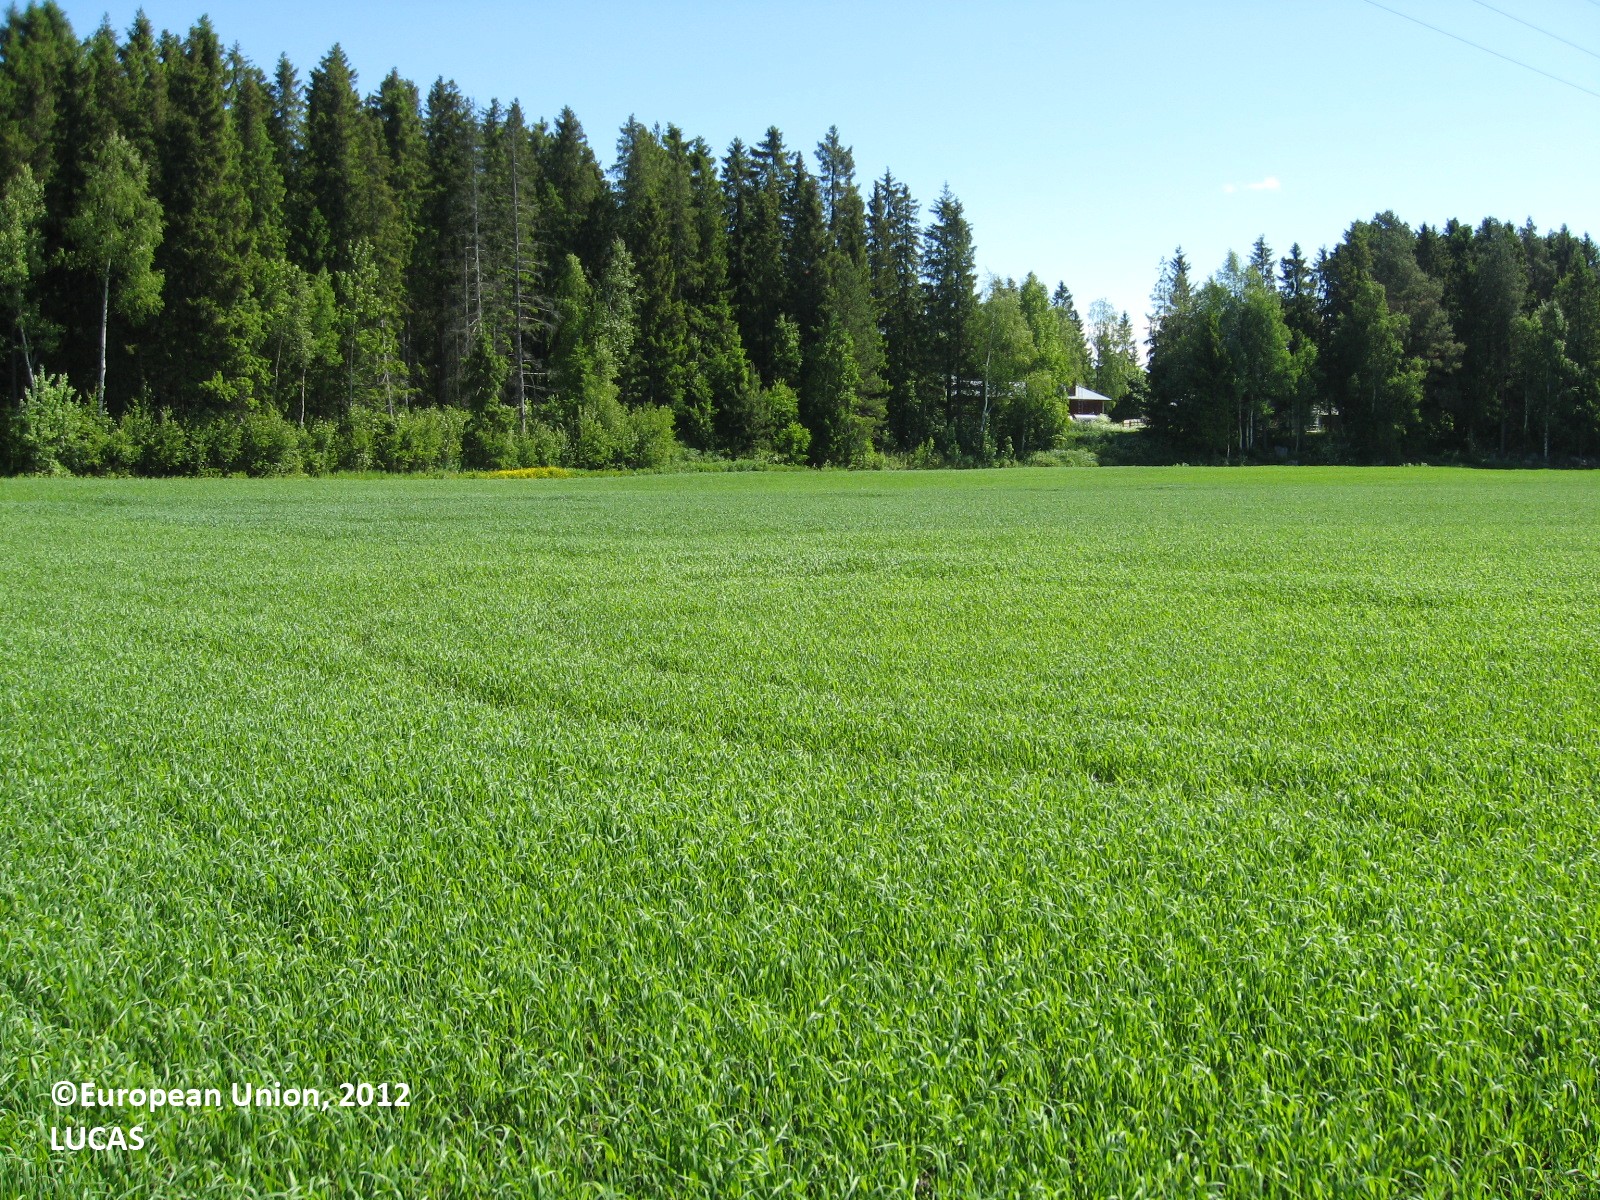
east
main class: Cropland
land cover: Oats
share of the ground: > 75 %
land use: Agriculture (excluding fallow land and kitchen gardens)
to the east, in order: Oats; Electric lines; Oats; Shruby margins; Ditches and canals; Spruce dominated coniferous woodland; Artificial constructions in urban areas; Spruce dominated coniferous woodland
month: June
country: FI
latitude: 62.9441
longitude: 21.6484
